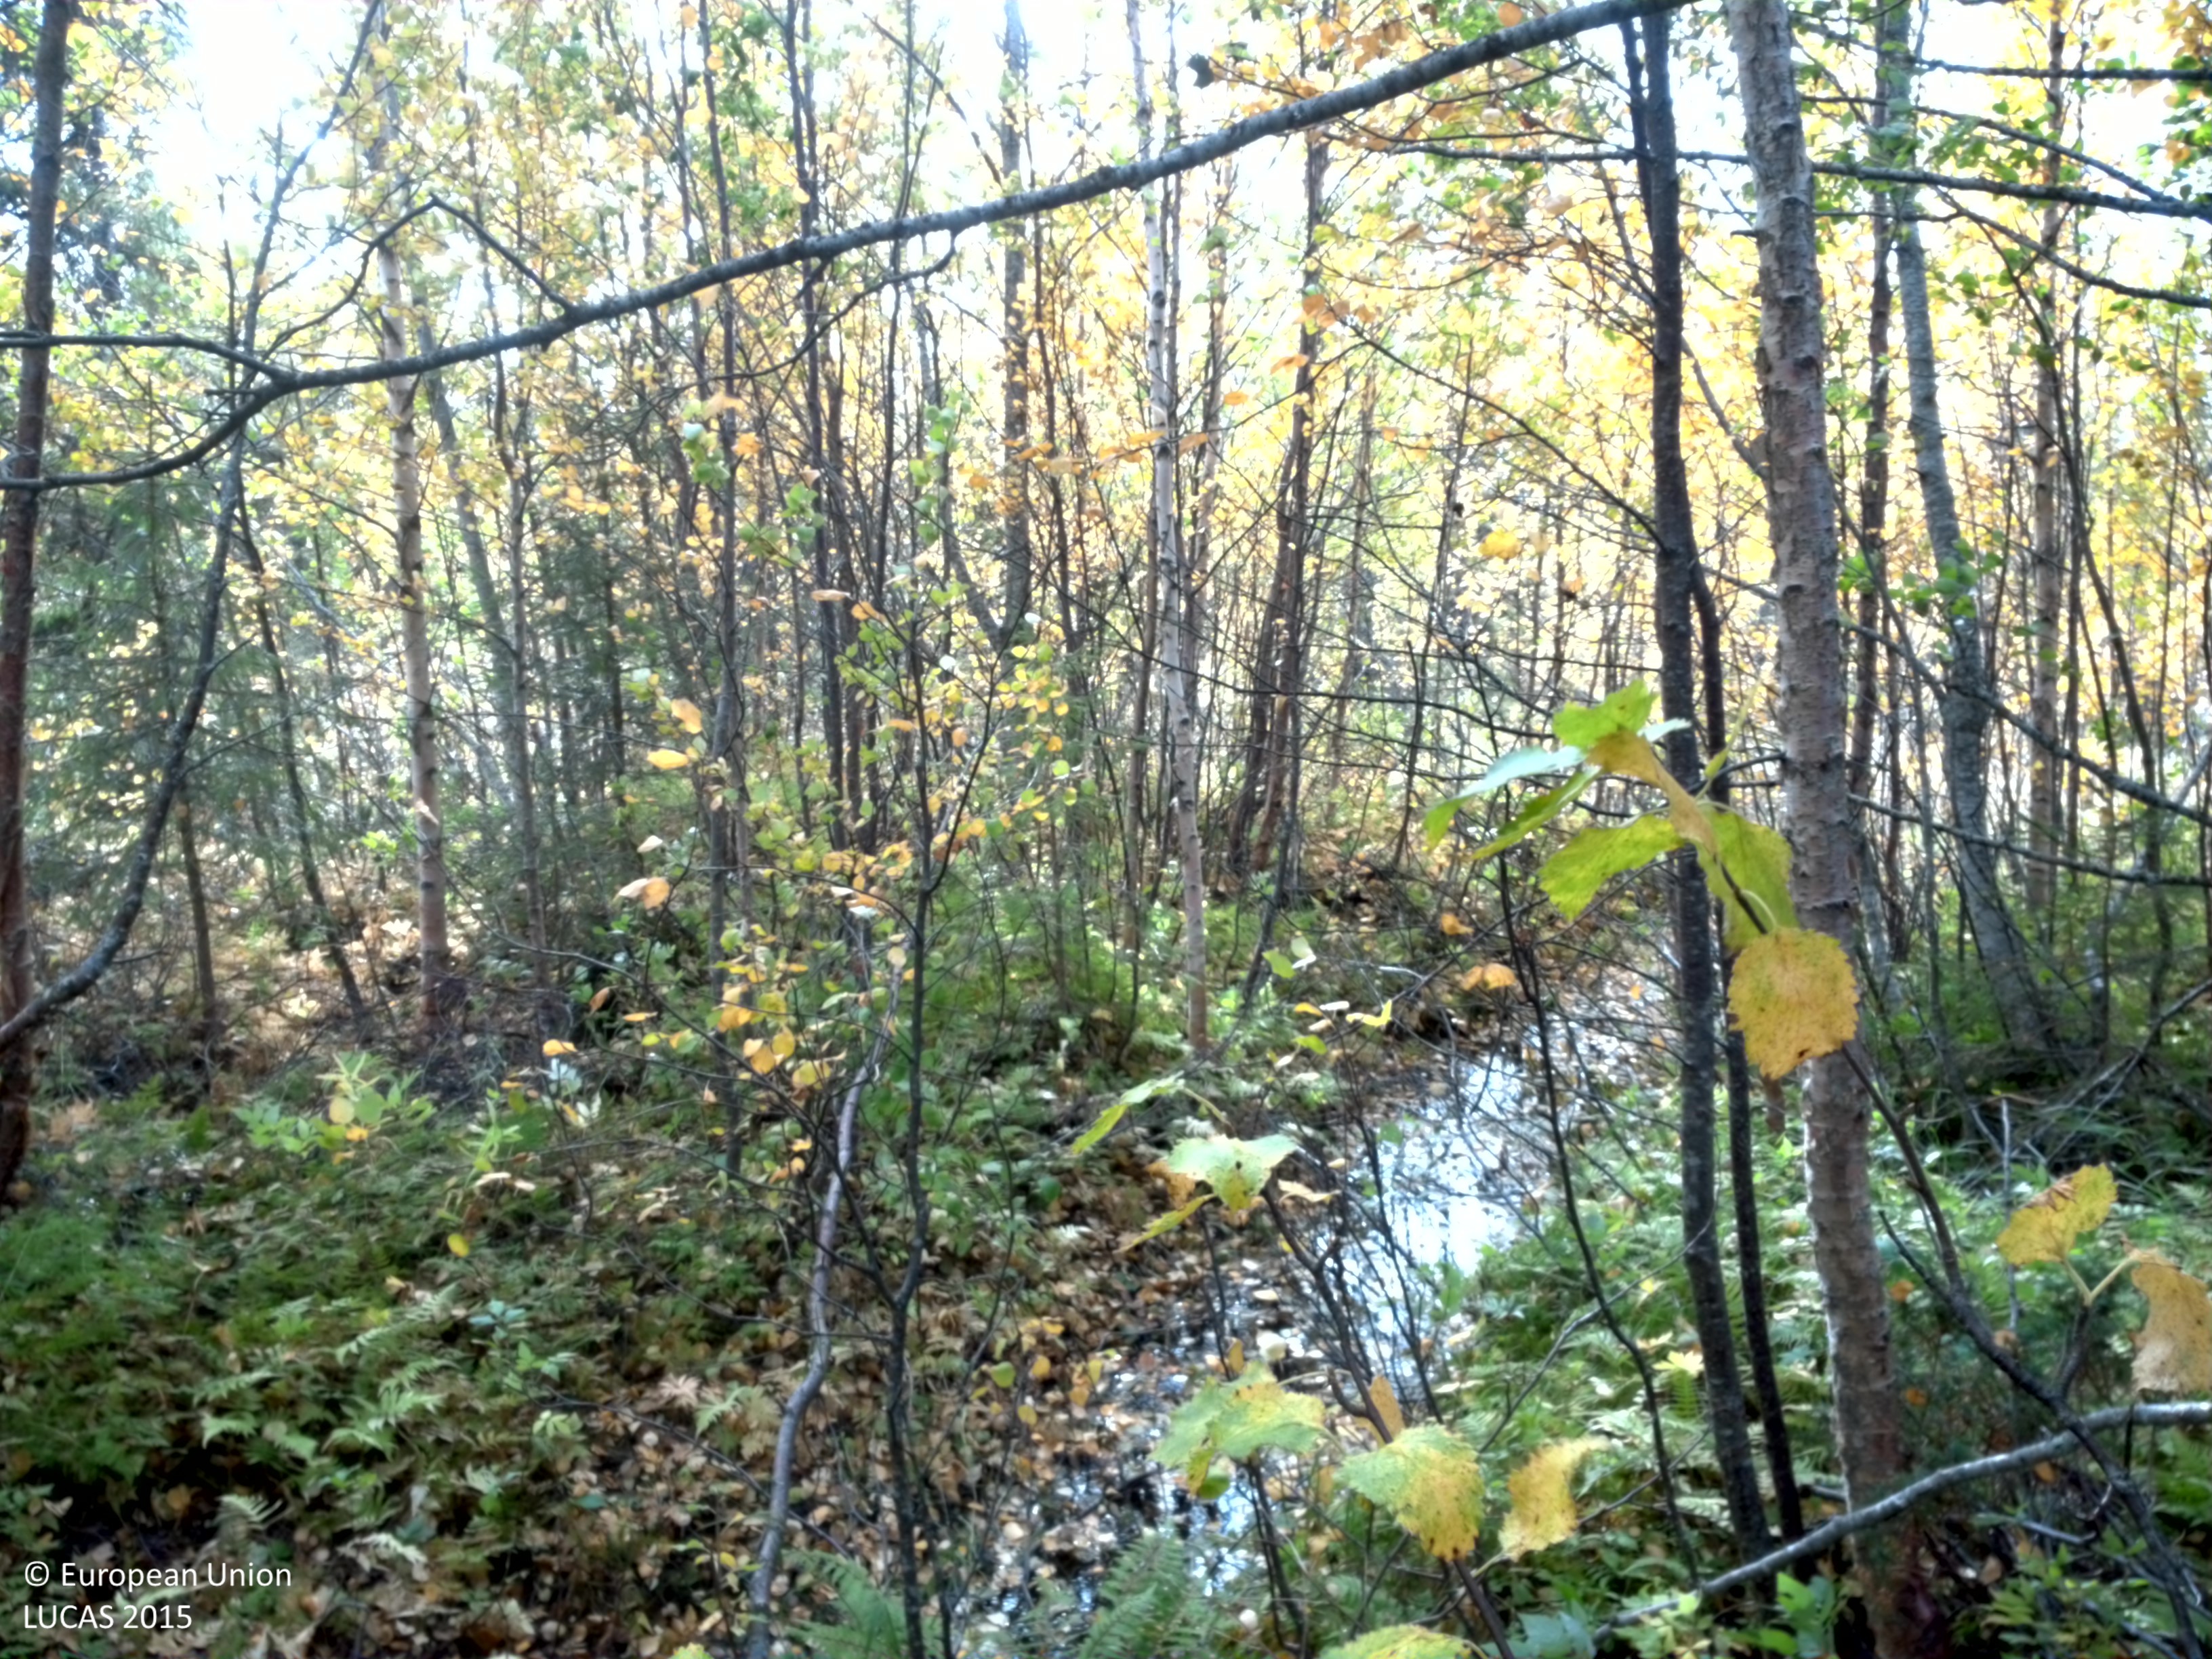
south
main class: Woodland
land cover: Broadleaved woodland
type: non-riverine alder, birch or aspen forest
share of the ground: > 75 %
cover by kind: broadleaved forest trees 70 %, herbaceous plants 15 %, coniferous forest trees 10 %, shrubs 5 %
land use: Semi-natural and natural areas not in use
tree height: > 5 m
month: September
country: SE
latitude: 65.3834
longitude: 16.1810
